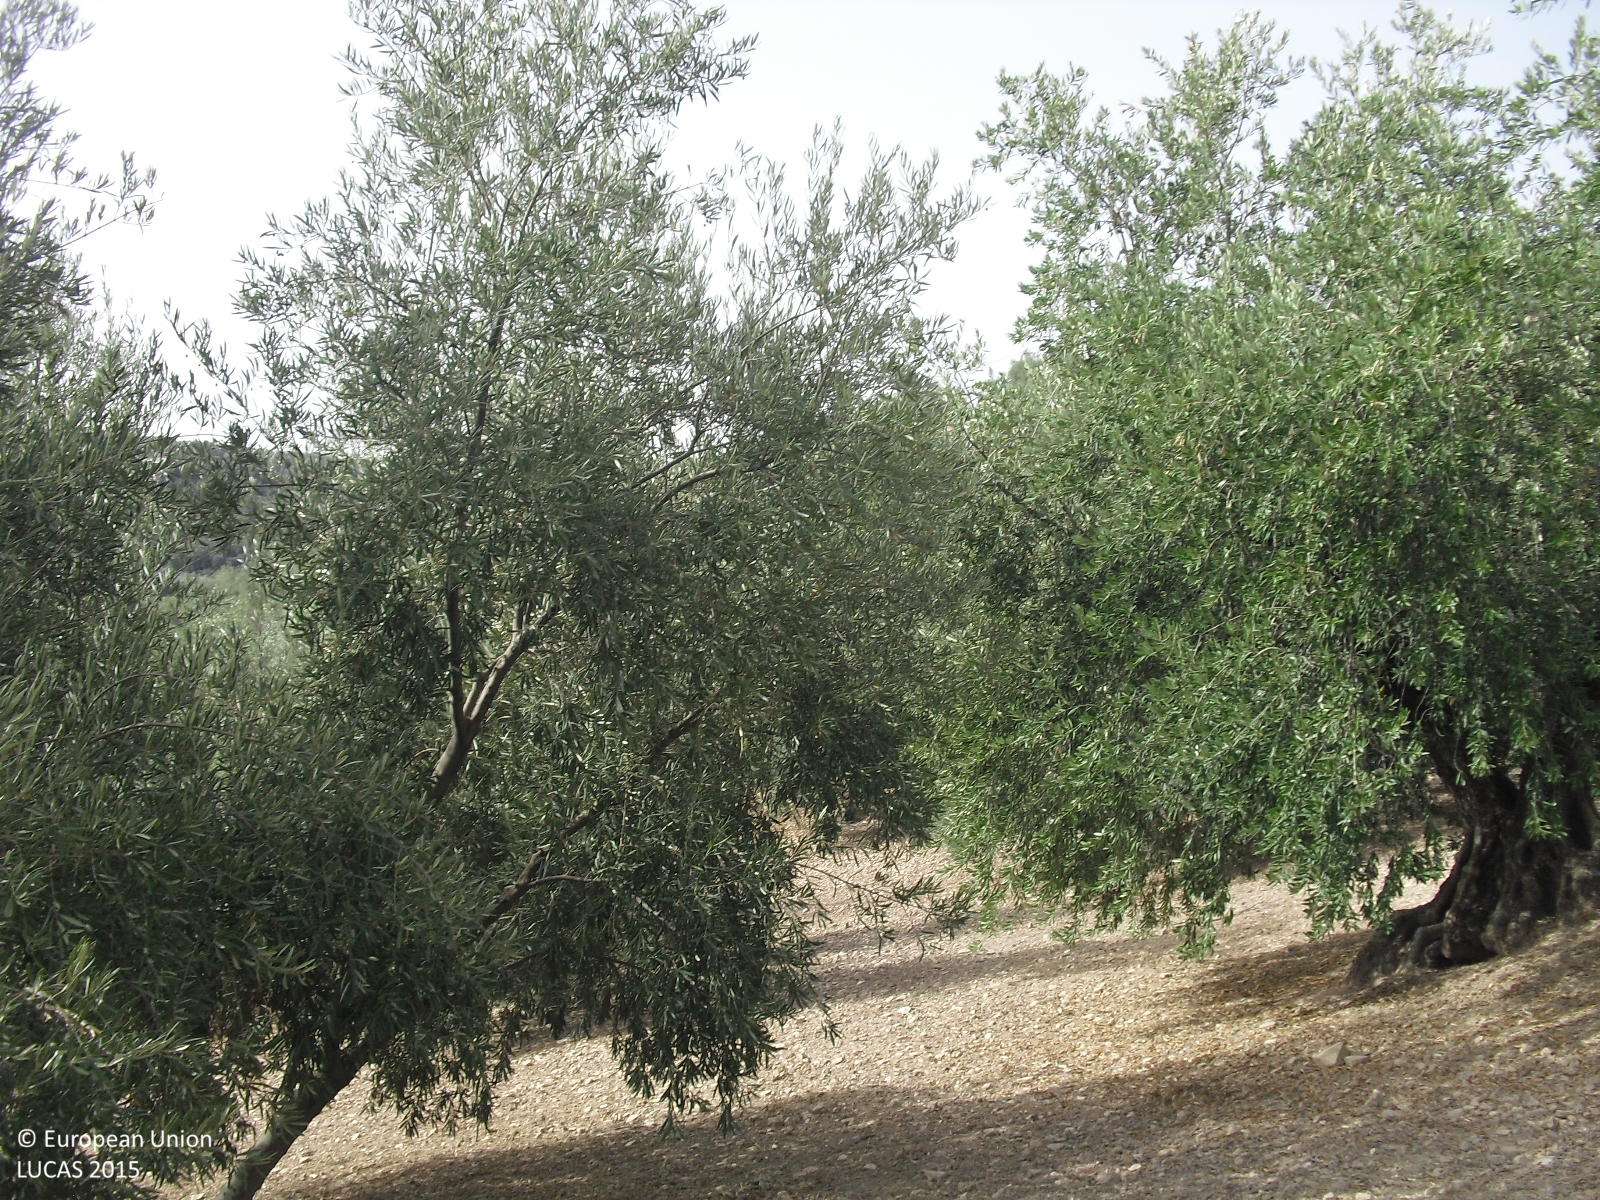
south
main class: Cropland
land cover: Olive groves
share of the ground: 25 - 50 %
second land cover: Other bare soil
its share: > 75 %
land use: Agriculture (excluding fallow land and kitchen gardens)
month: August
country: ES
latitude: 37.2450
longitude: -4.3263
